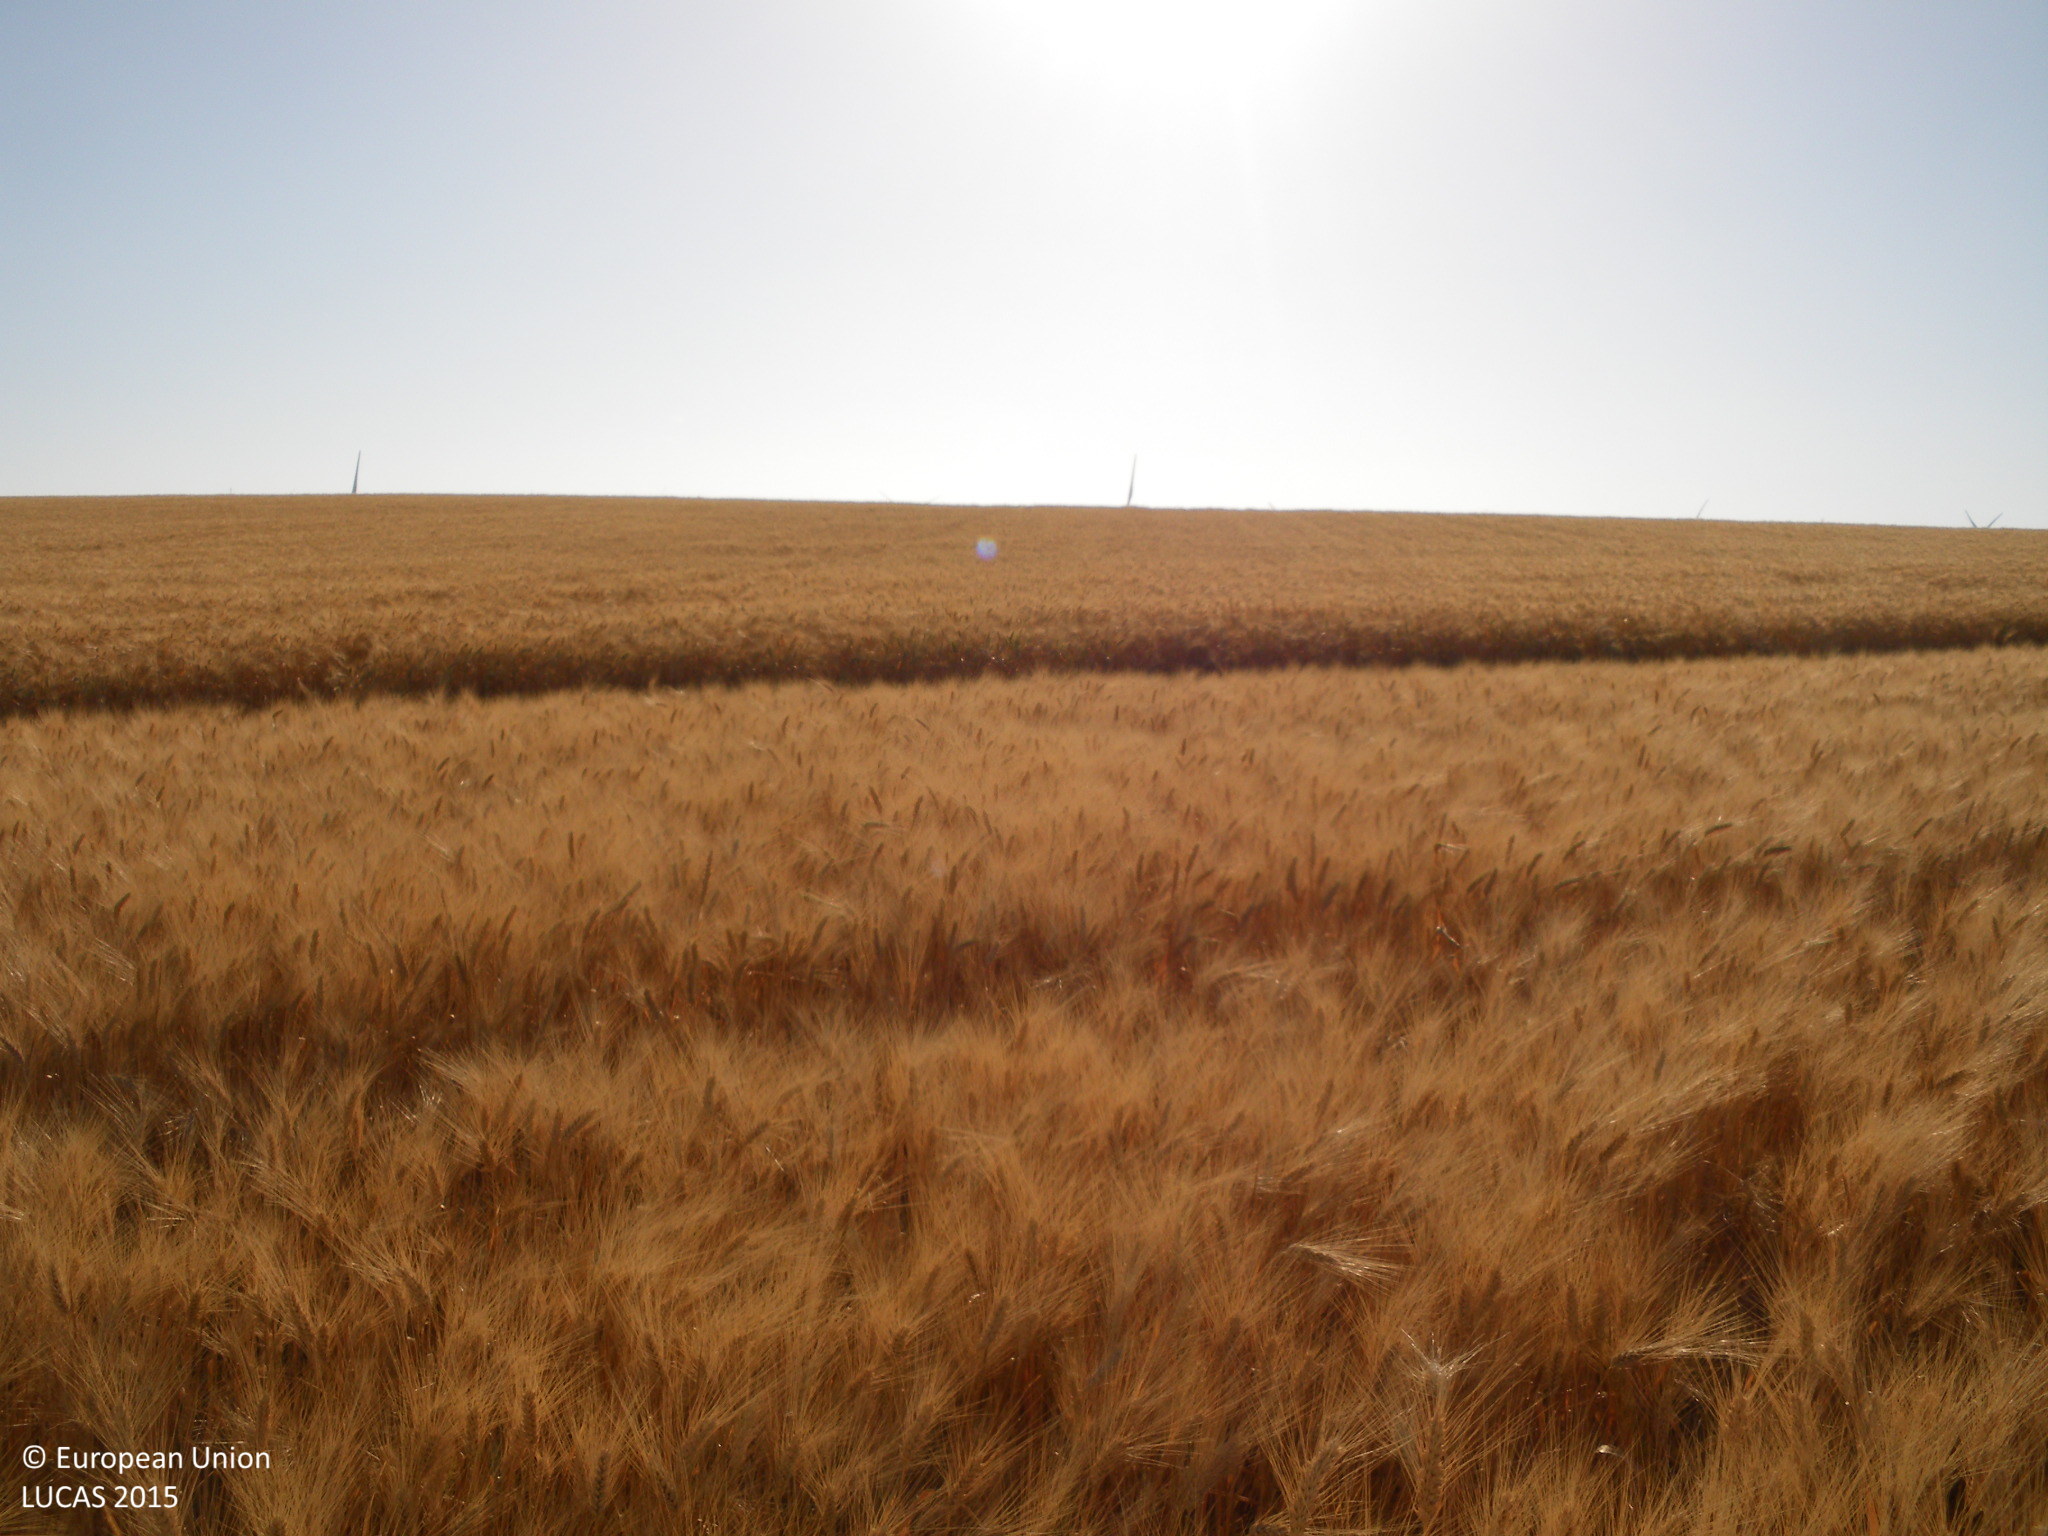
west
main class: Cropland
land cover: Durum wheat
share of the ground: > 75 %
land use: Agriculture (excluding fallow land and kitchen gardens)
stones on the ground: < 10 %
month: May
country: ES
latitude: 36.7683
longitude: -6.2263
